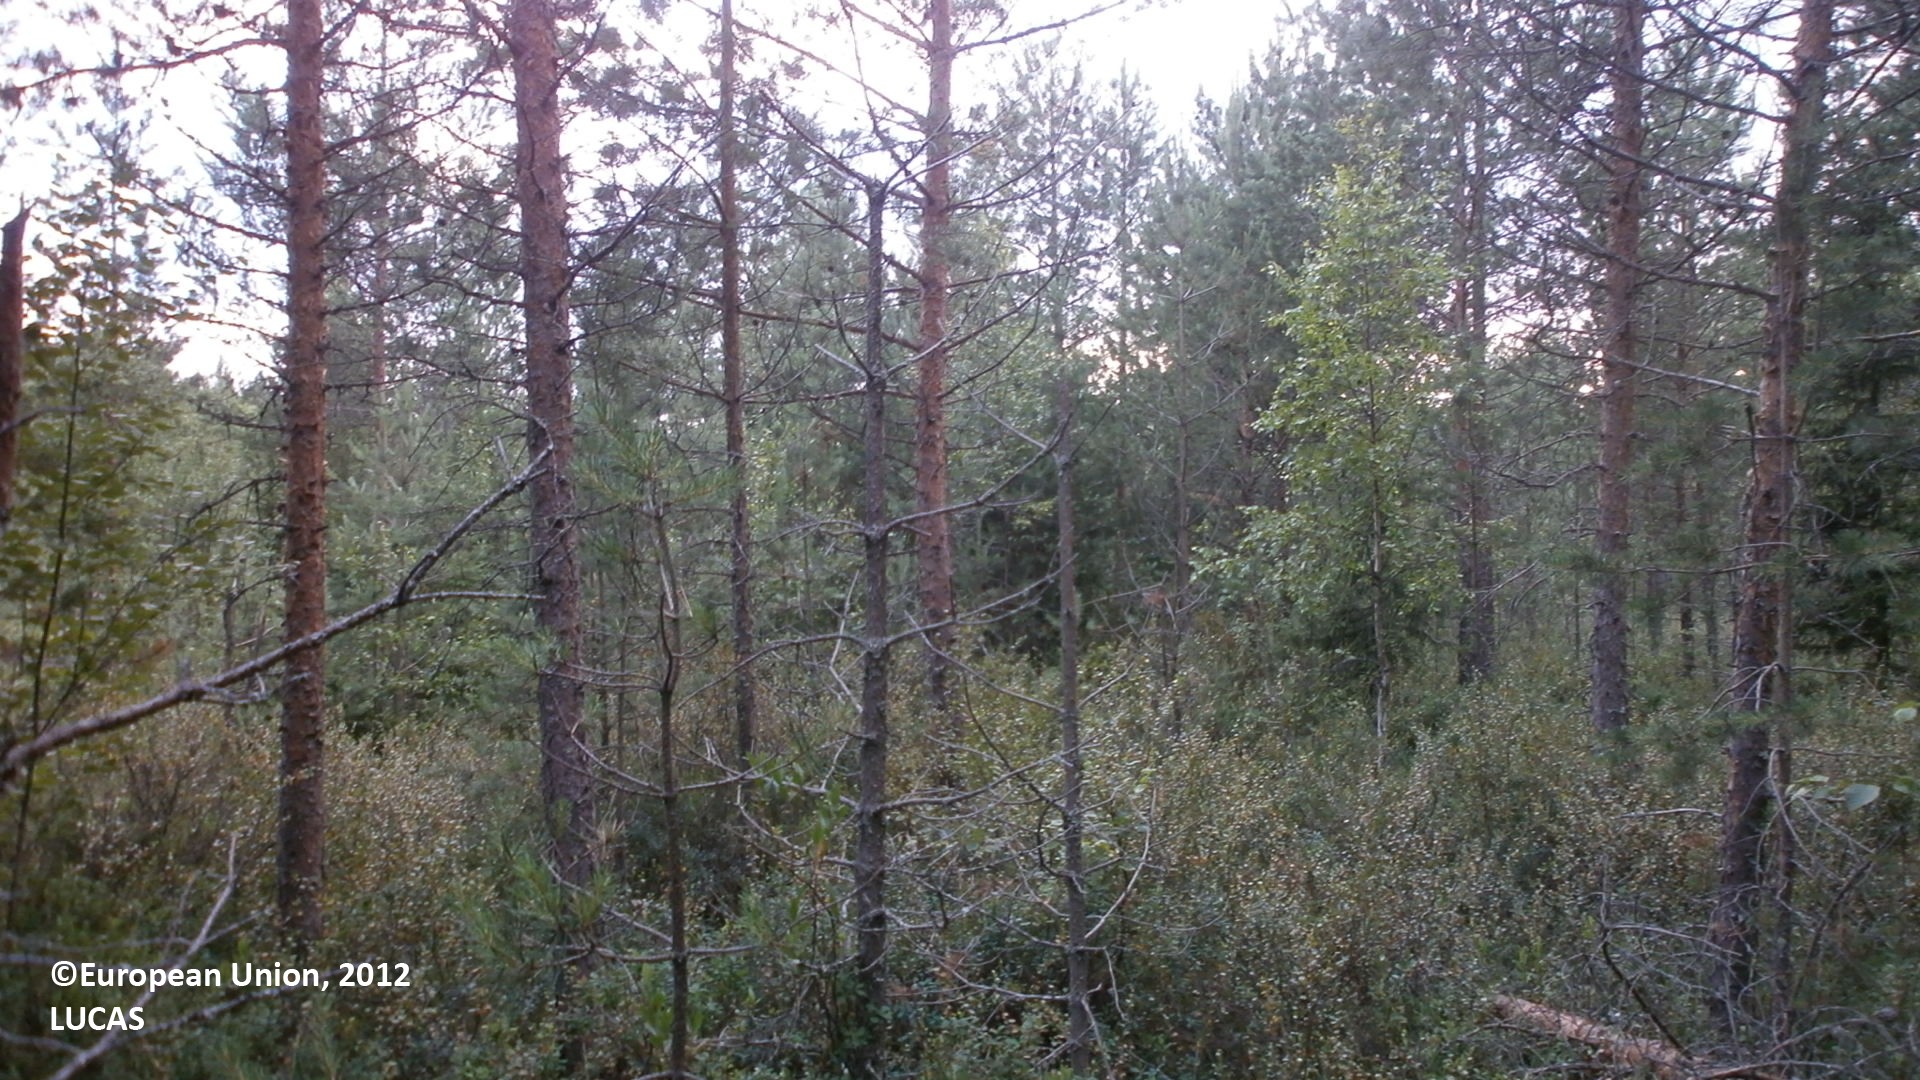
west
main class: Woodland
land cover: Pine dominated mixed woodland
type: boreal forest
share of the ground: 50 - 75 %
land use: Forestry
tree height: > 5 m
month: July
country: FI
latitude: 64.1153
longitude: 24.0880
